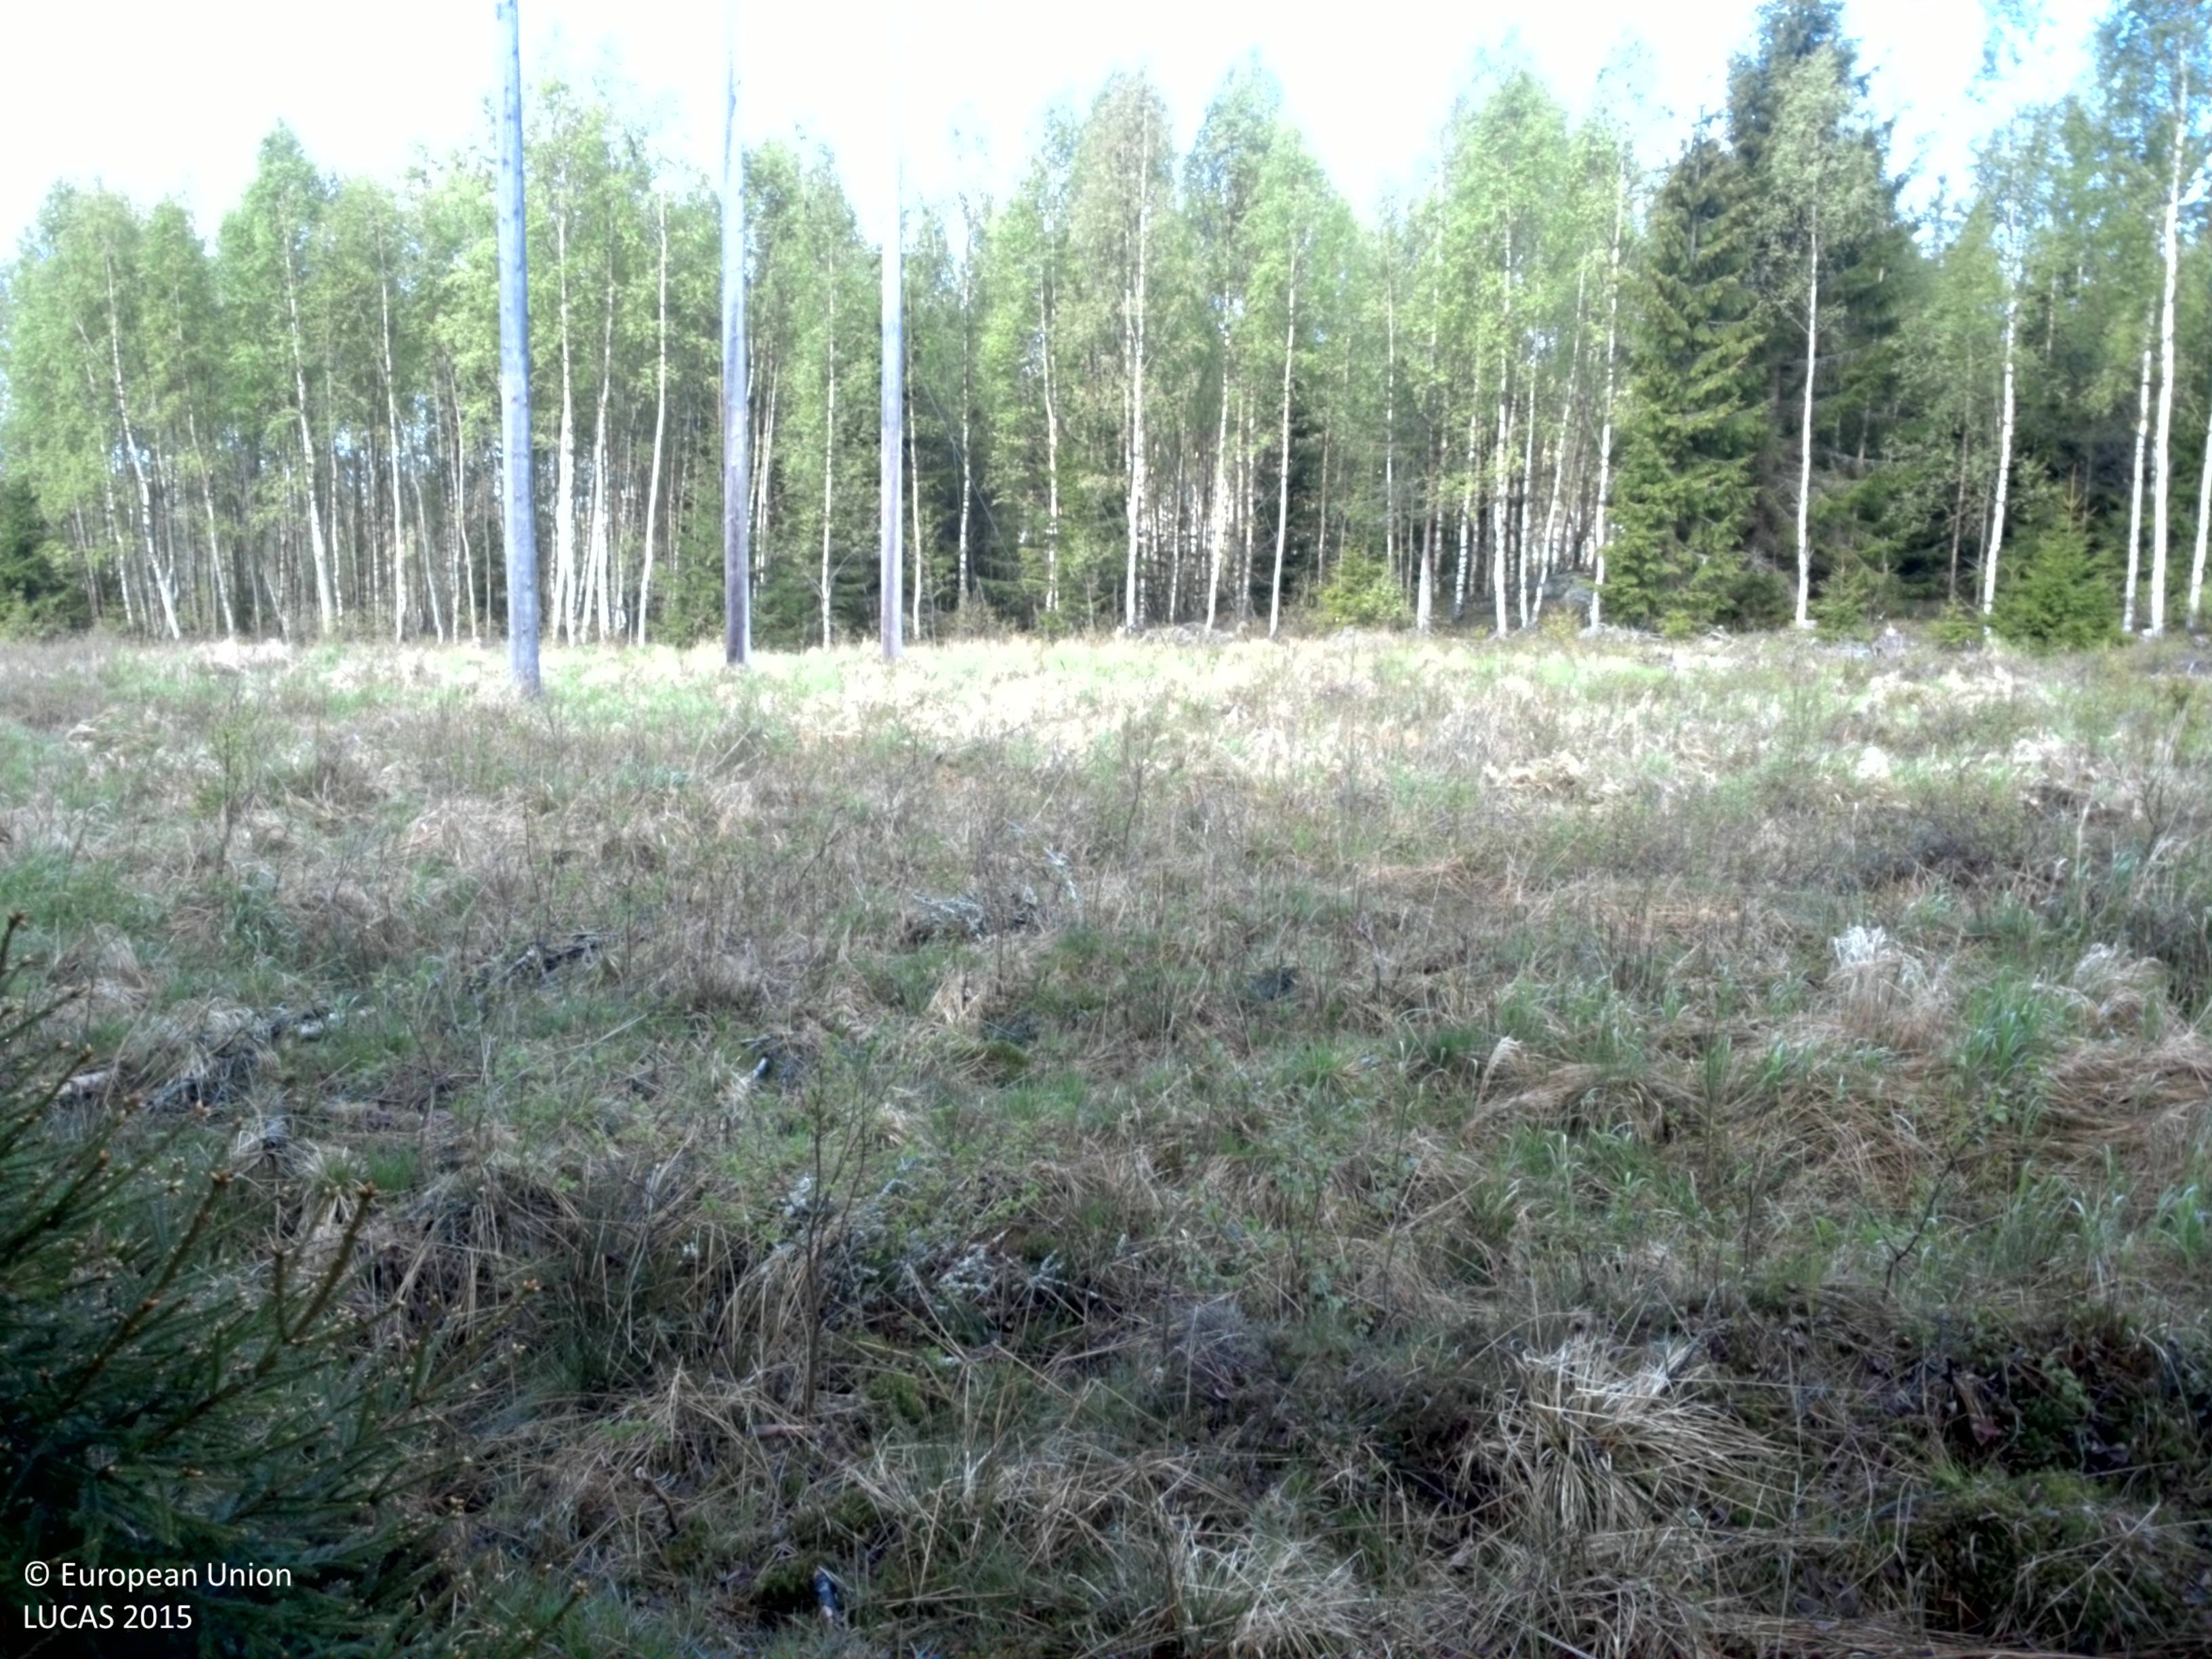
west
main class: Woodland
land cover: Broadleaved woodland
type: hemiboreal forest and nemoral coniferous forest and mixed broadleaved-coniferous forest
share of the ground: 10 - 25 %
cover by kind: herbaceous plants 50 %, shrubs 30 %, broadleaved forest trees 10 %, lichens and mosses 10 %
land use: Electricity, gas and thermal power distribution
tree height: < 5 m
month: May
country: SE
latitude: 59.2905
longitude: 14.1524
